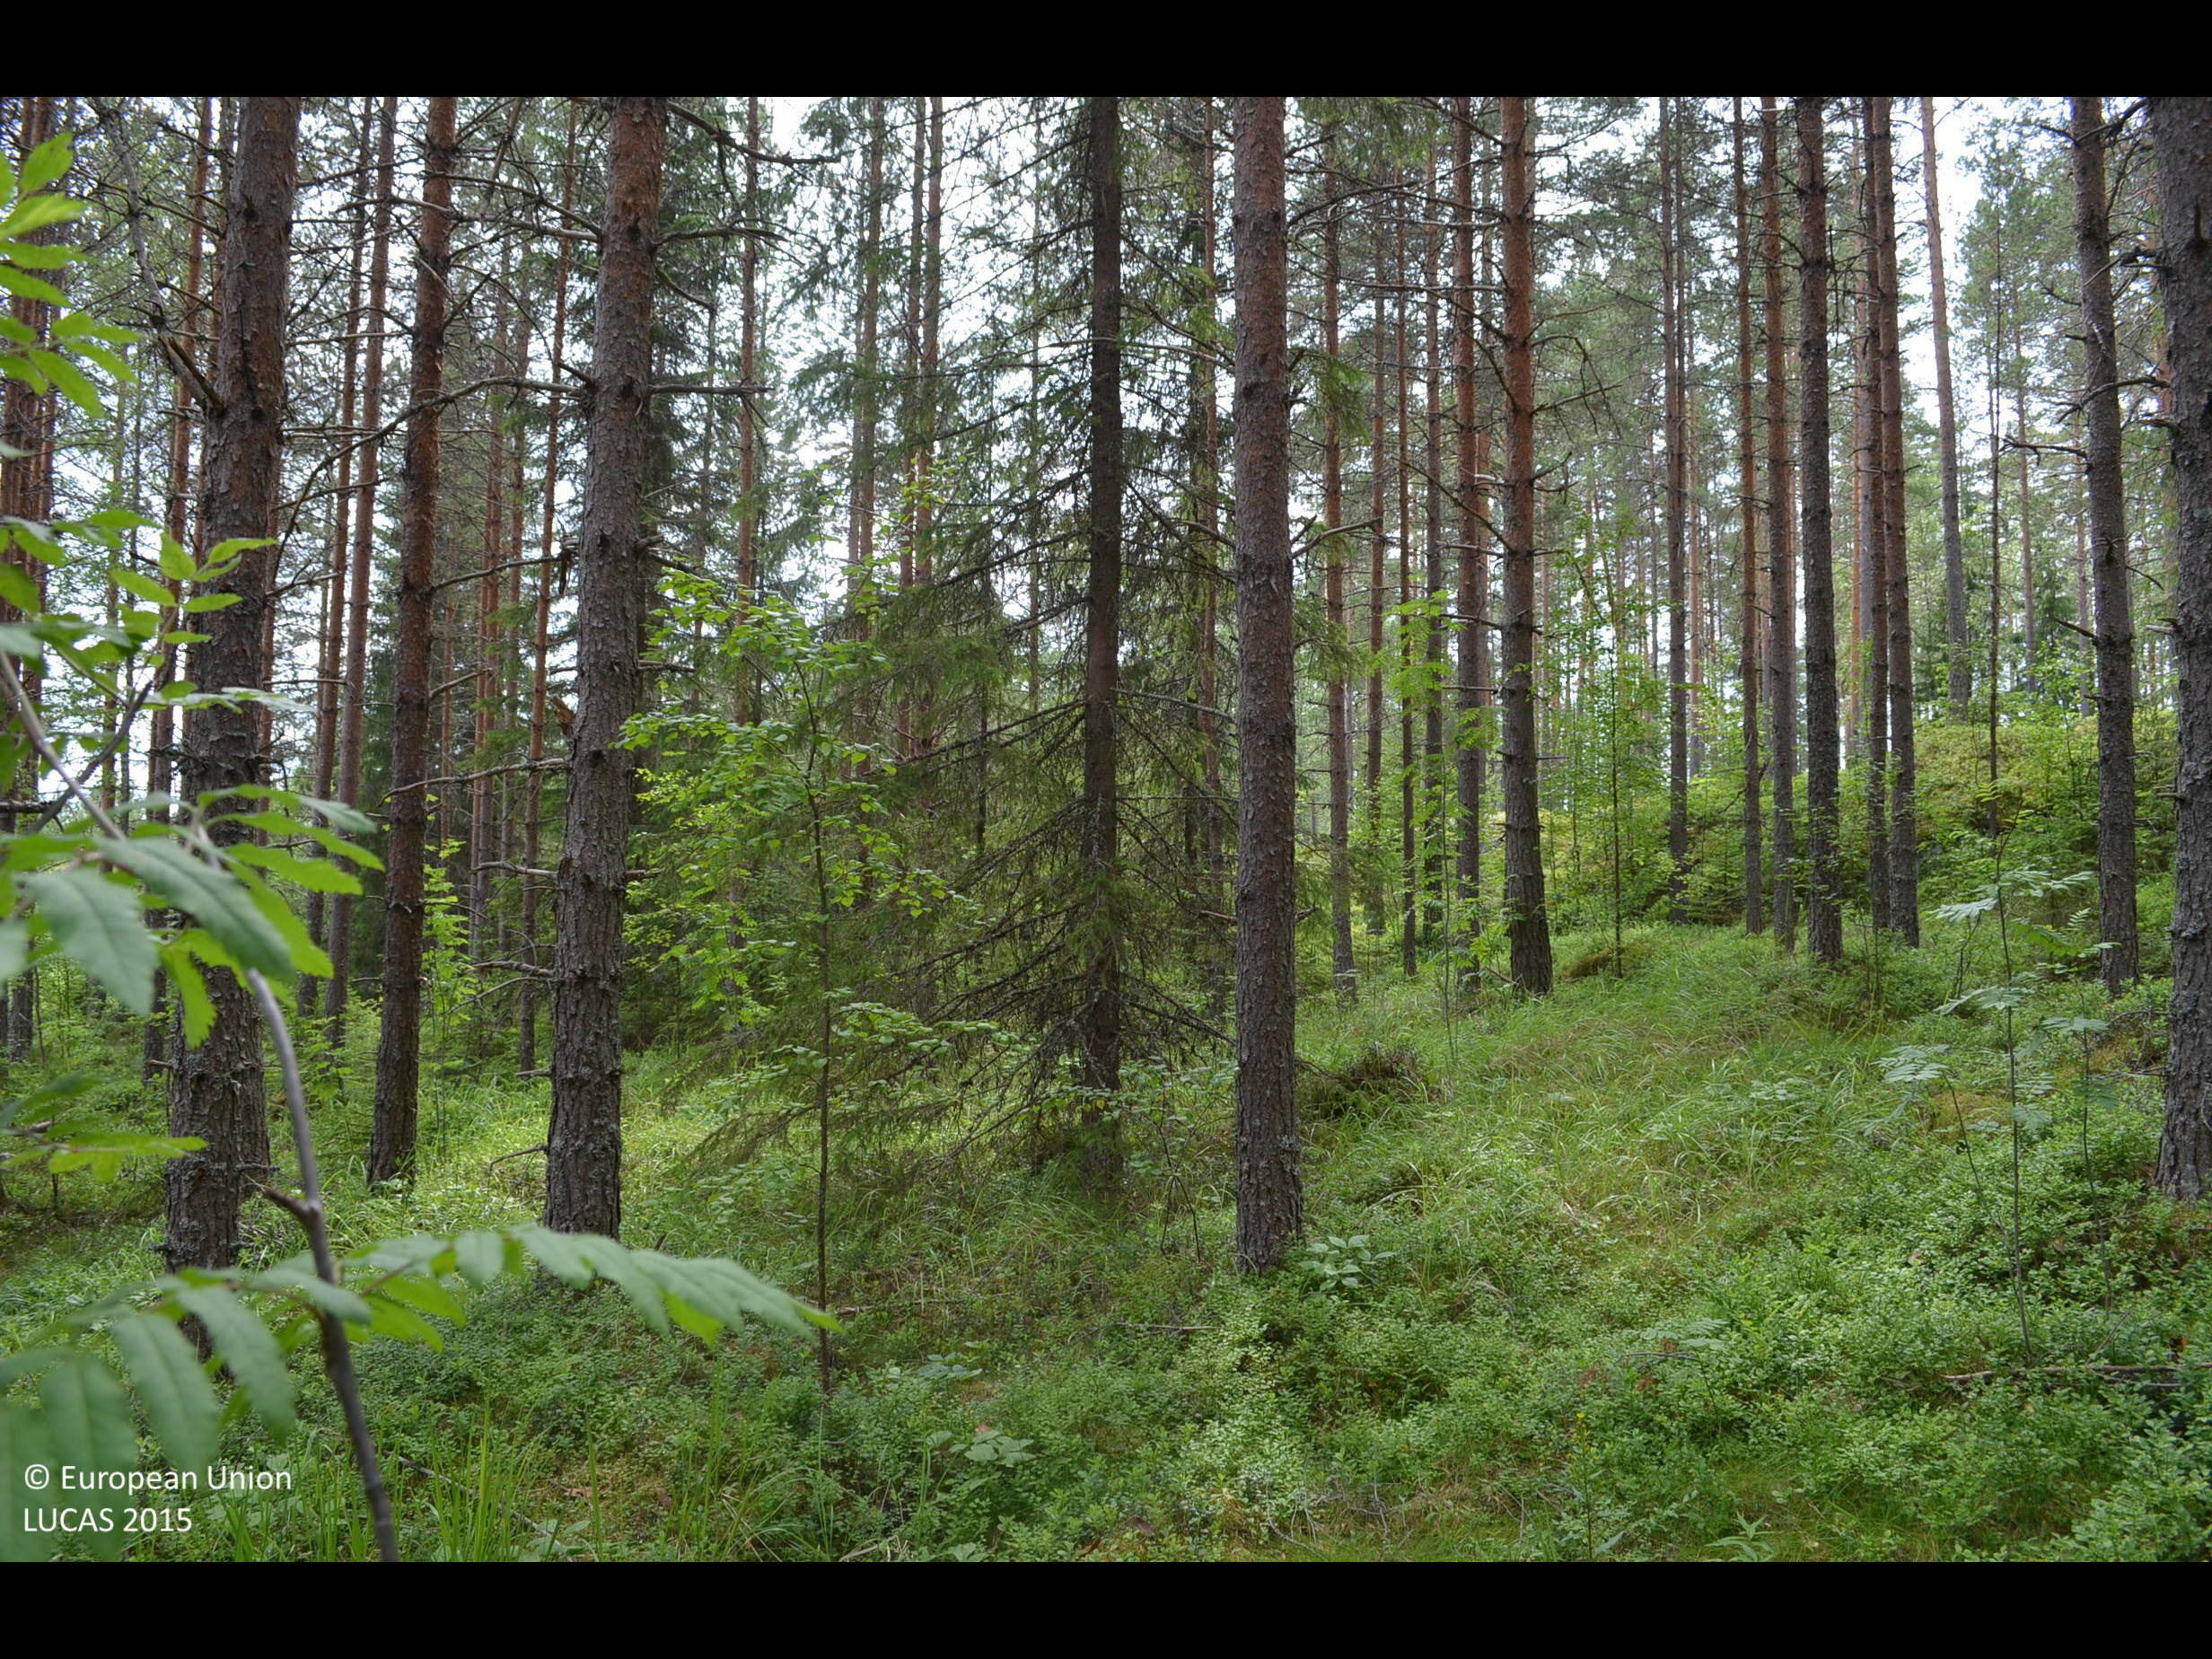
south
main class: Woodland
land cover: Pine dominated coniferous woodland
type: boreal forest
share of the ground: > 75 %
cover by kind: coniferous forest trees 75 %, shrubs 20 %, broadleaved forest trees 5 %
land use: Forestry
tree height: > 5 m
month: July
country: FI
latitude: 62.1806
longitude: 23.5390
